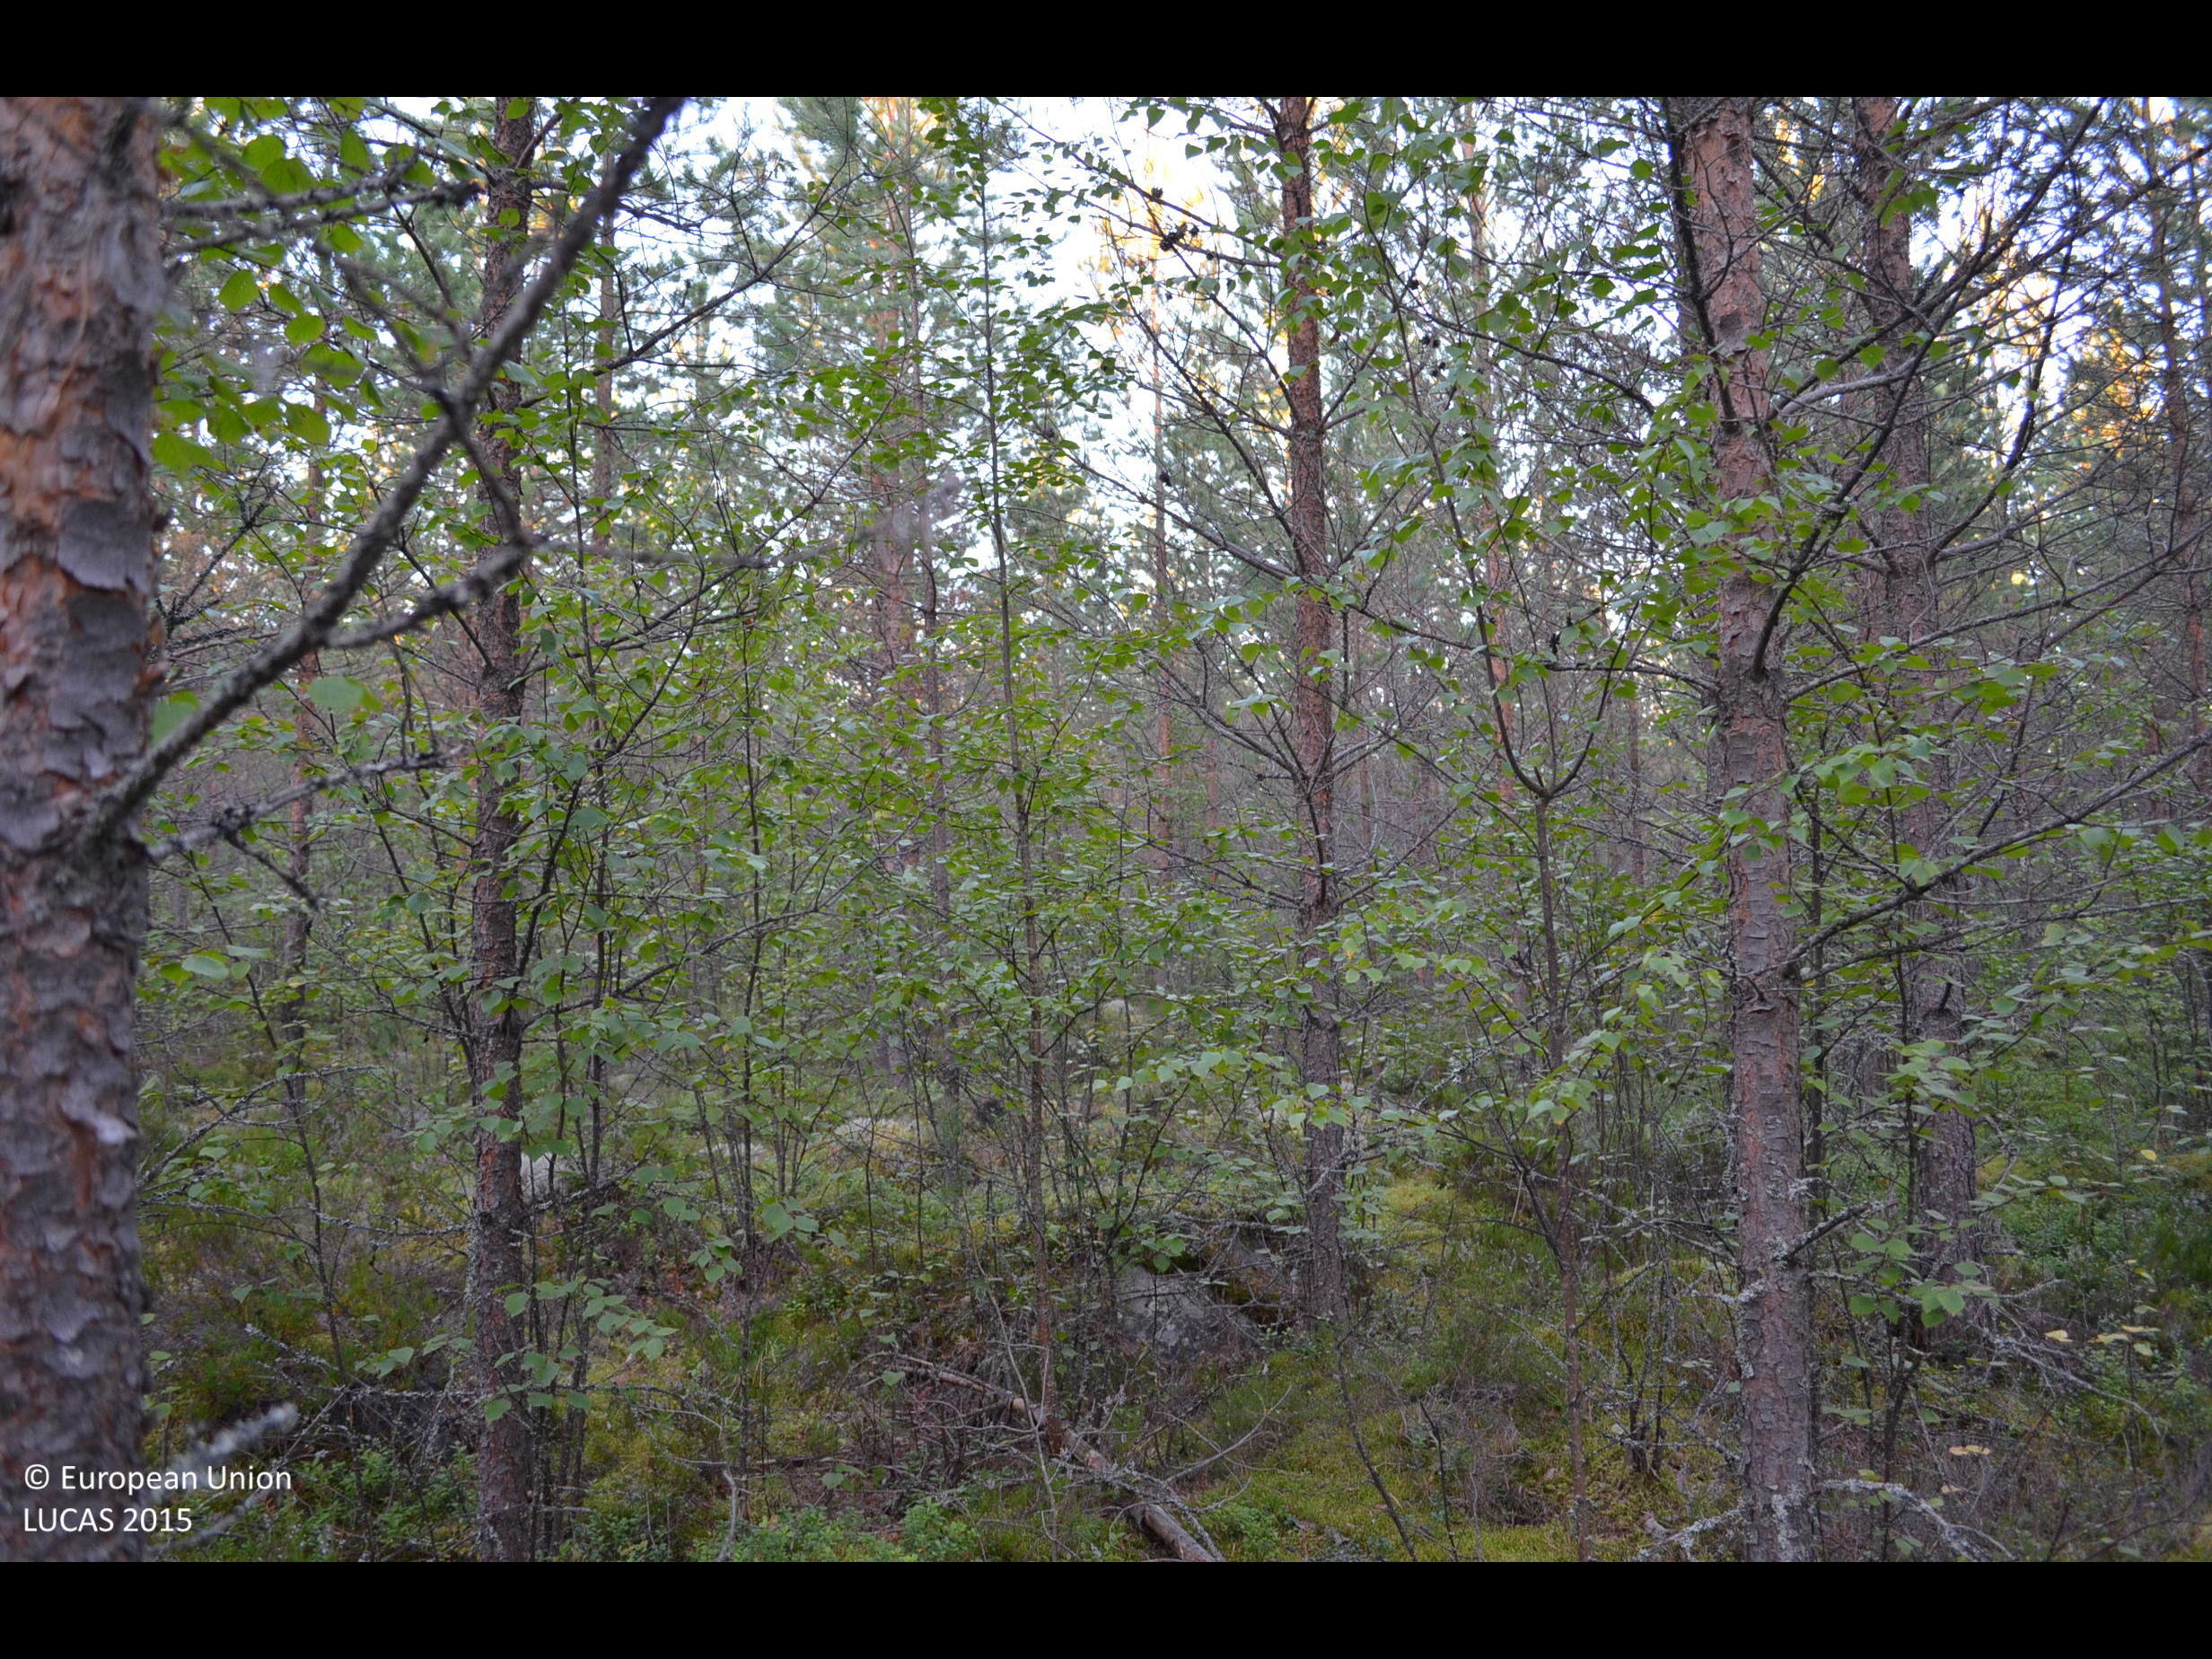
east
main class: Woodland
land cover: Pine dominated coniferous woodland
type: boreal forest
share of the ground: > 75 %
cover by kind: coniferous forest trees 65 %, shrubs 20 %, broadleaved forest trees 15 %
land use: Forestry
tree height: > 5 m
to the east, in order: Pine dominated coniferous woodland
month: August
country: FI
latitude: 62.3735
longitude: 24.4132
